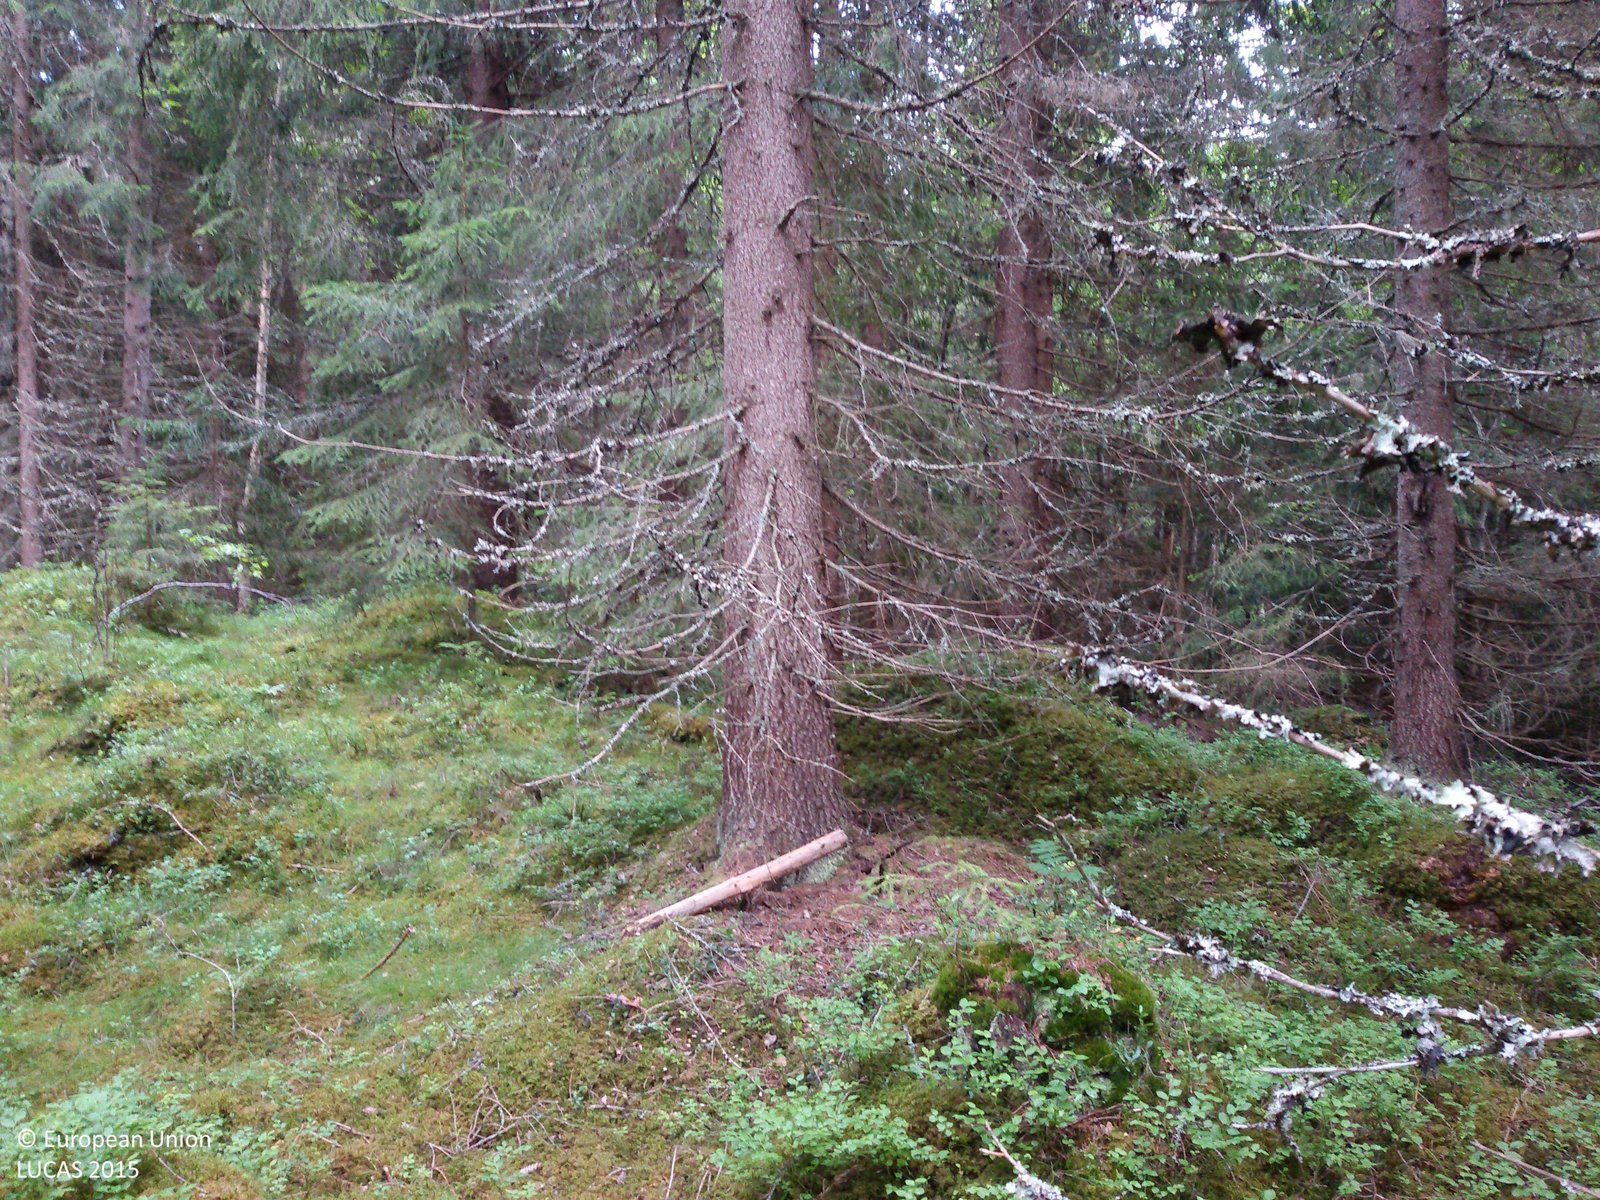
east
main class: Woodland
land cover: Spruce dominated coniferous woodland
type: boreal forest
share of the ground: > 75 %
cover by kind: coniferous forest trees 80 %, herbaceous plants 10 %, lichens and mosses 10 %
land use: Forestry
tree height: > 5 m
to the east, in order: Spruce dominated coniferous woodland; Rivers and streams; Spruce dominated mixed woodland; Pine dominated coniferous woodland
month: July
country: SE
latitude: 60.3649
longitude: 14.9378
